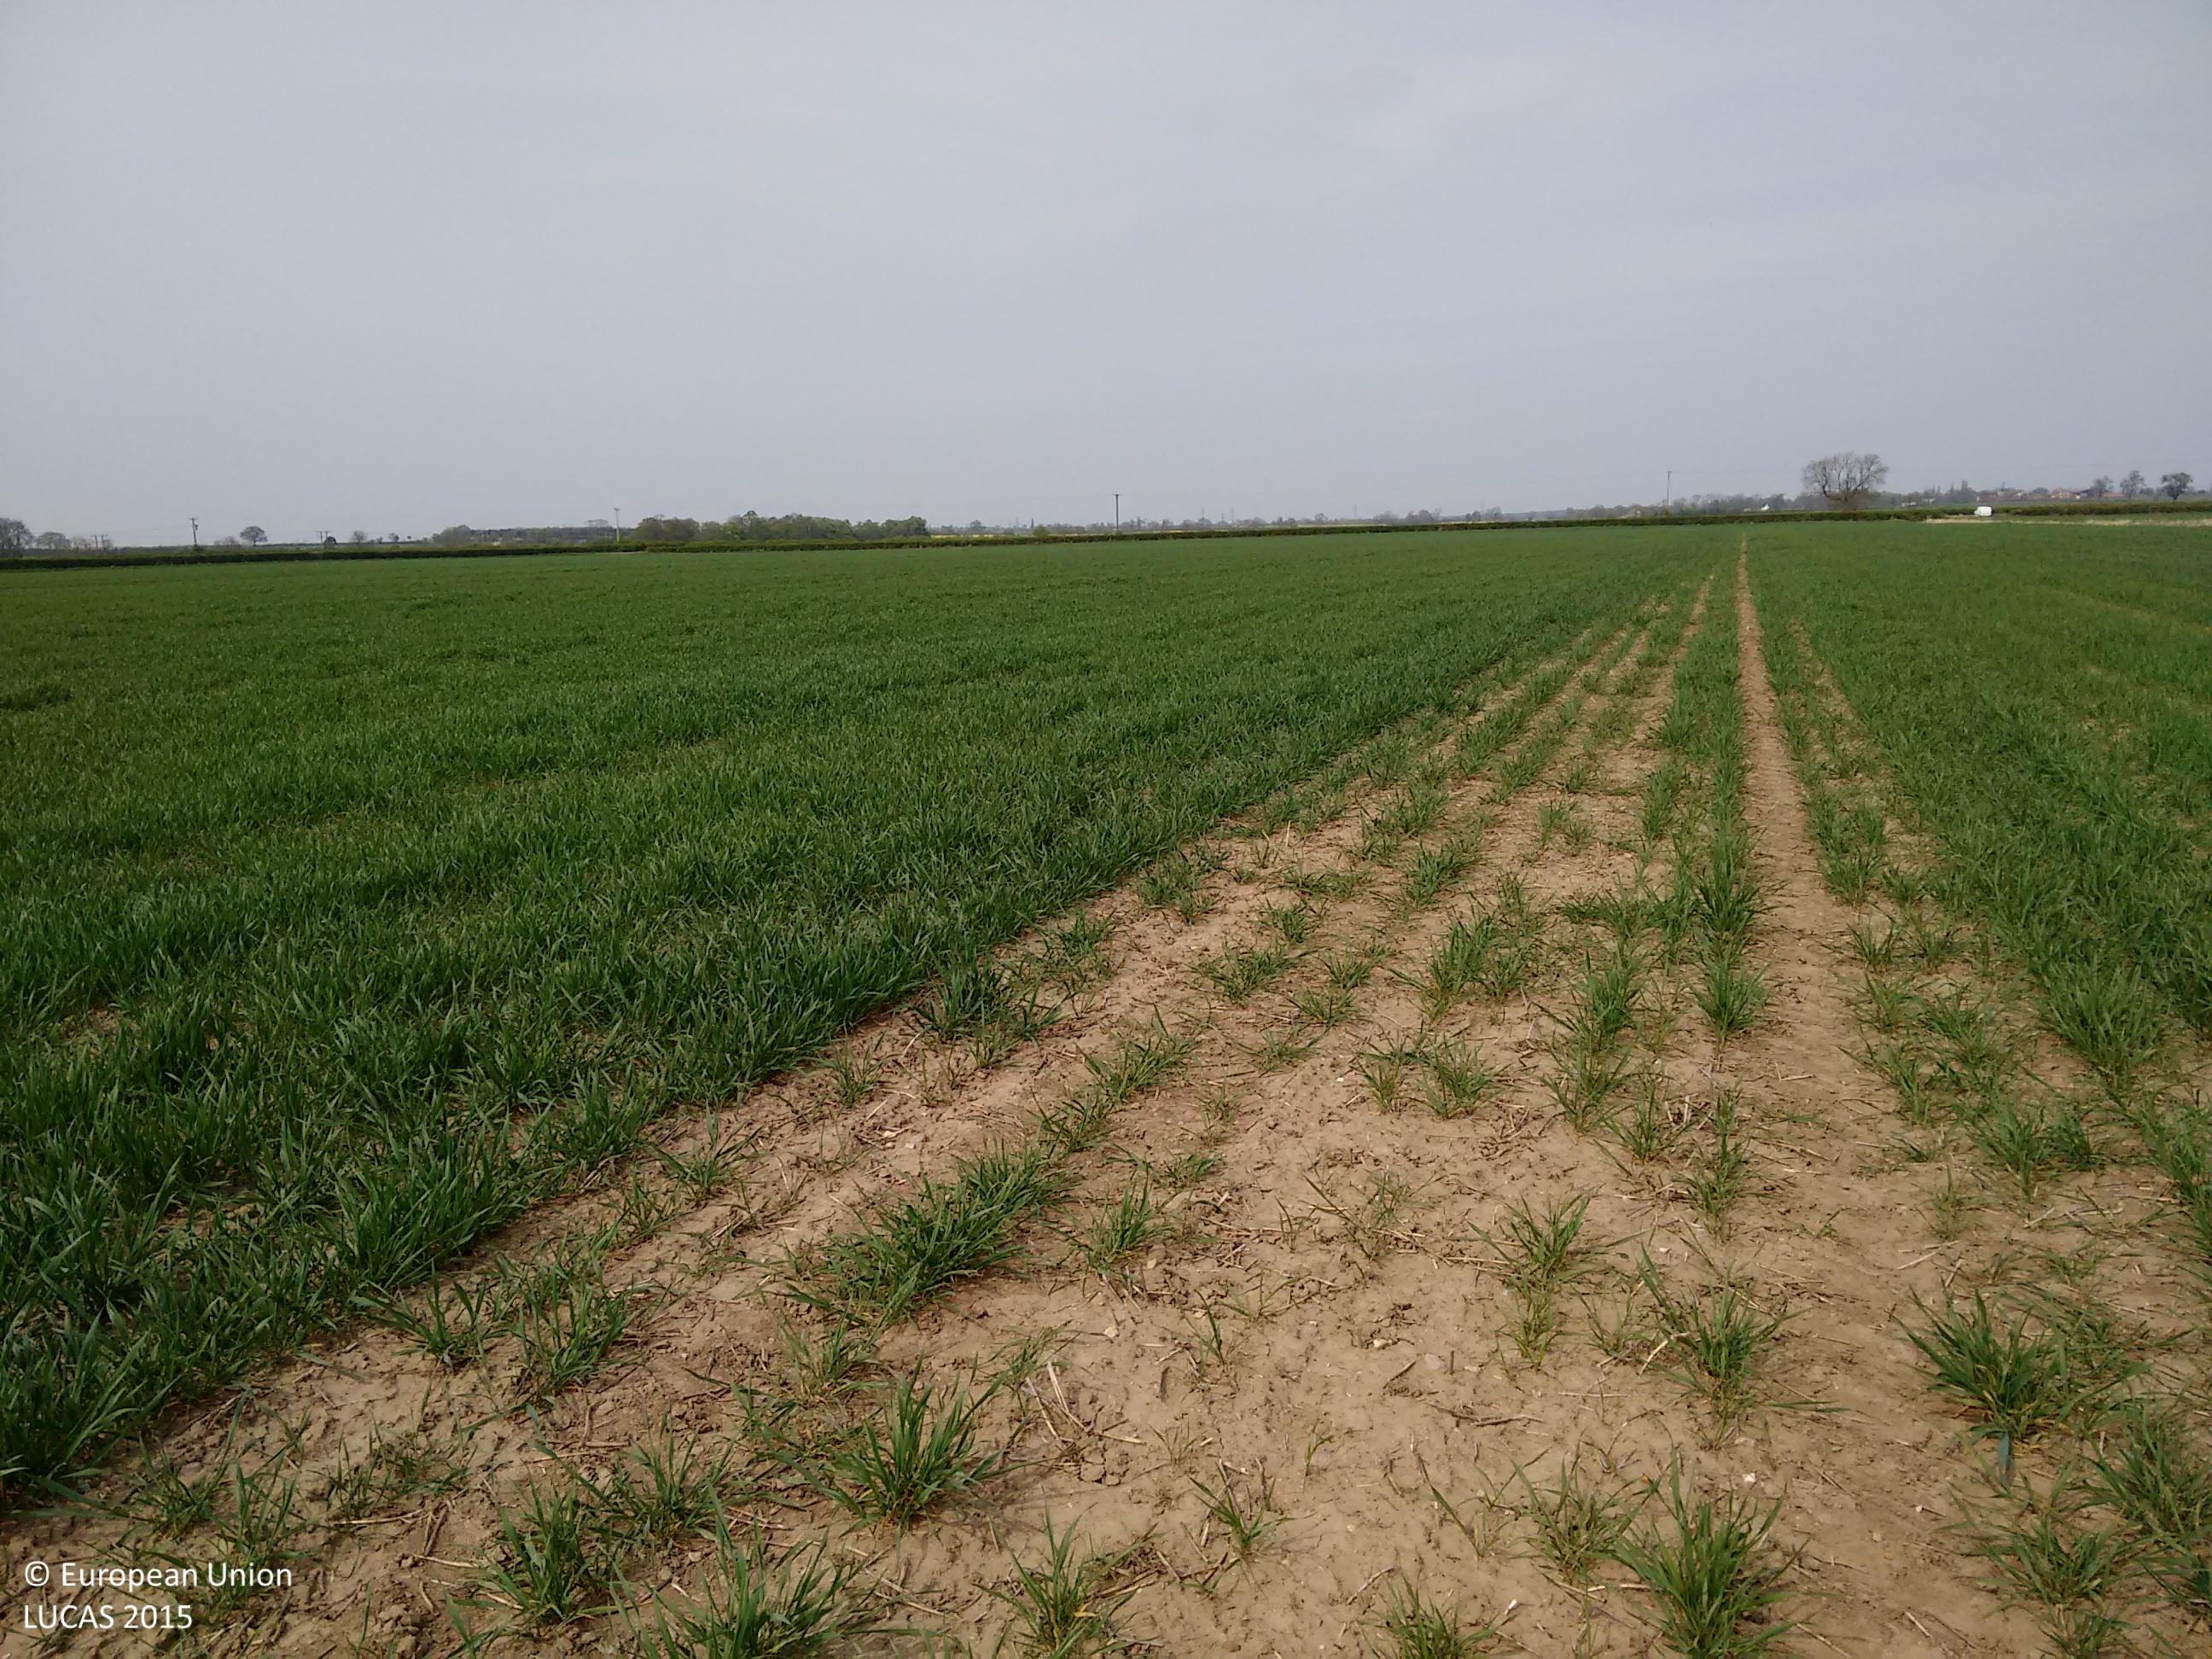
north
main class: Cropland
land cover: Barley
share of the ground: 50 - 75 %
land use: Agriculture (excluding fallow land and kitchen gardens)
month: April
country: GB
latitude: 53.4156
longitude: -0.7071
